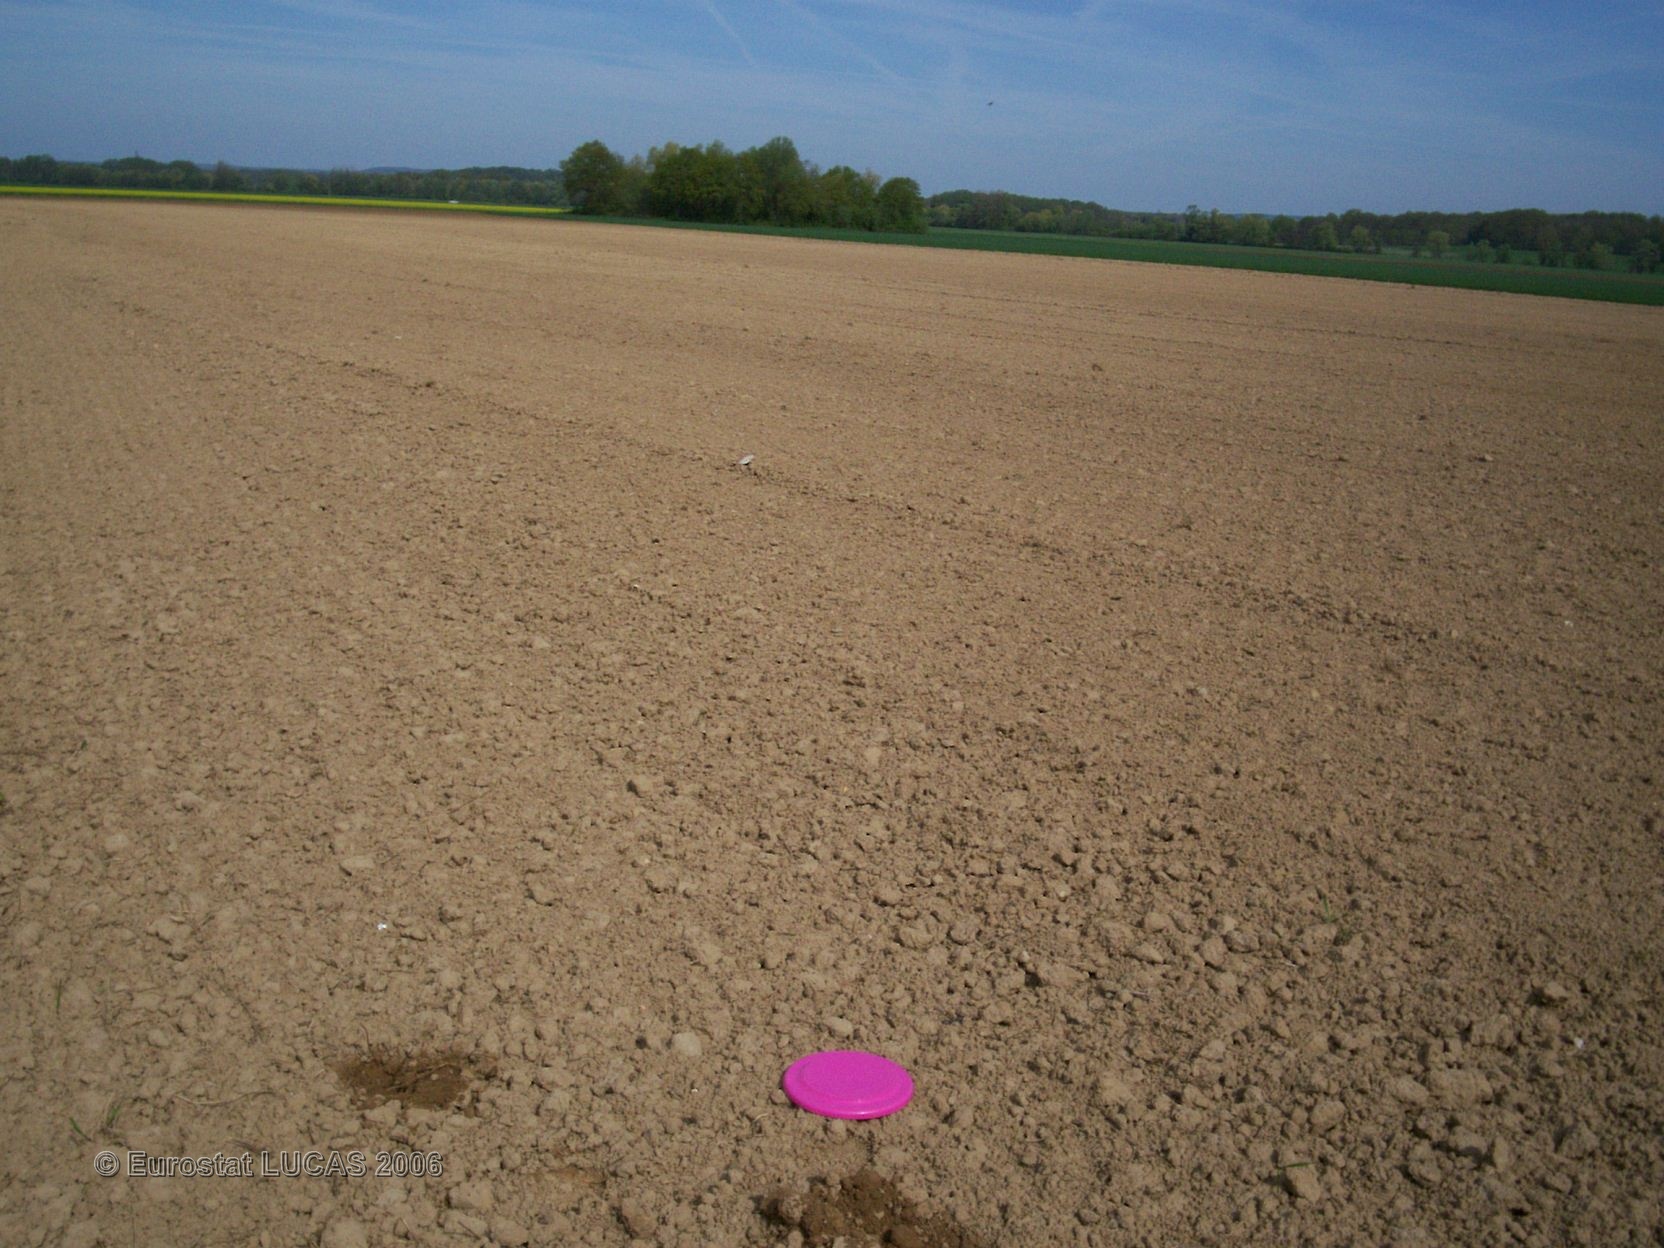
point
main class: Cropland
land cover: Other leguminous and mixtures for fodder
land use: Agriculture (excluding fallow land and kitchen gardens)
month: May
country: FR
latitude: 48.0436
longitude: 4.0275
